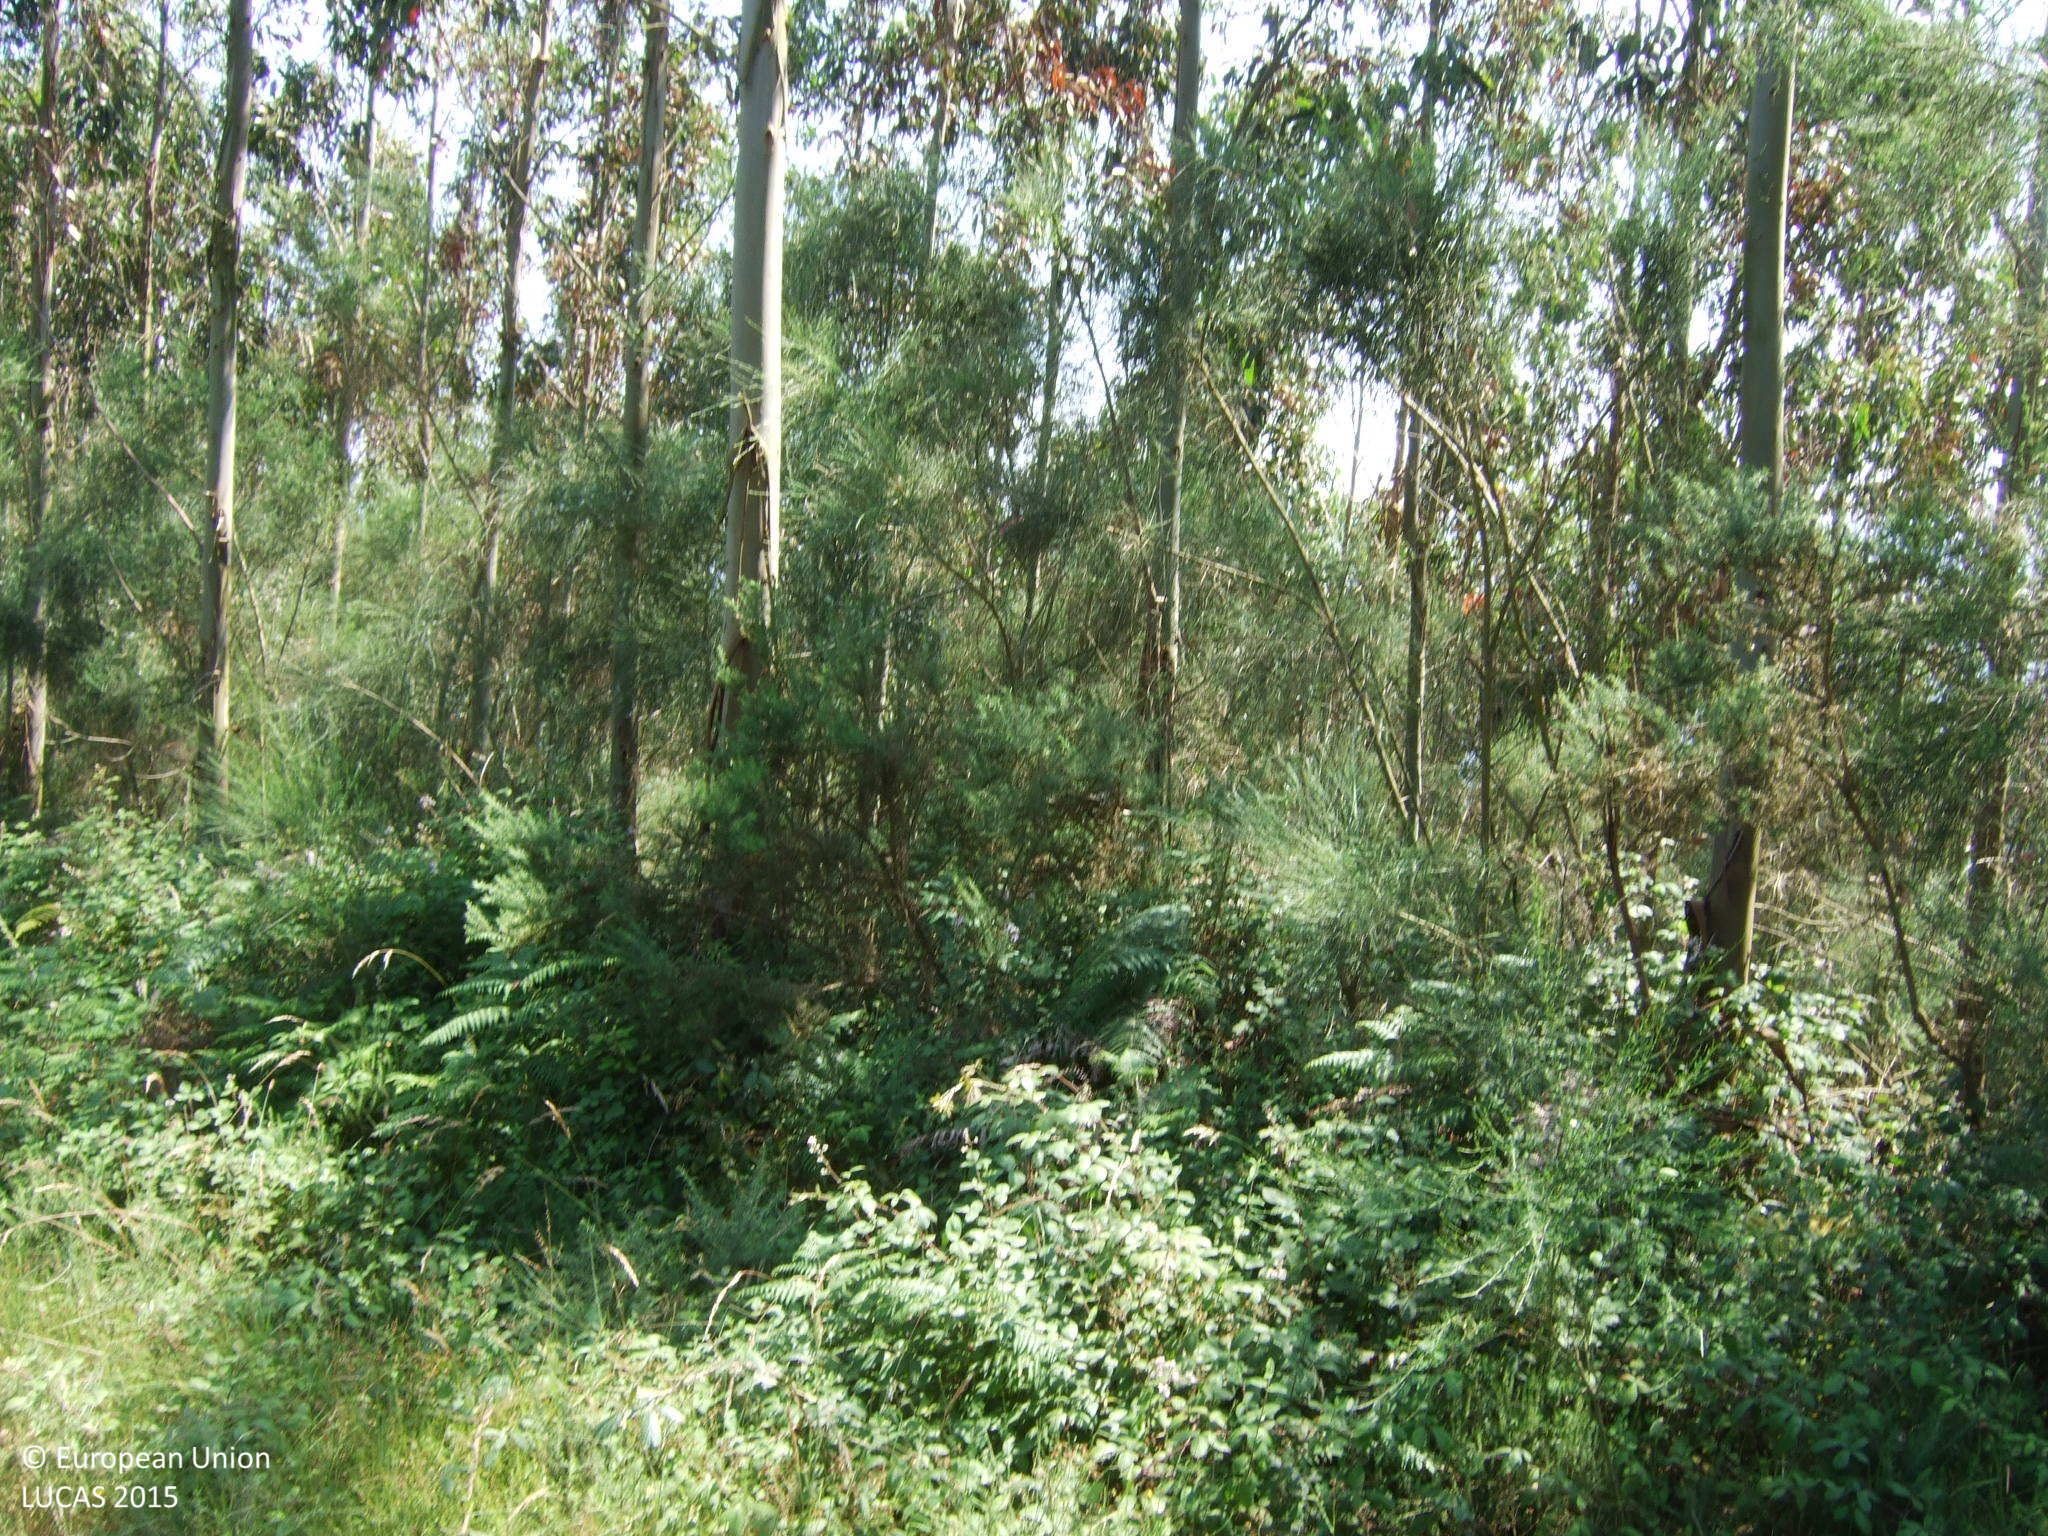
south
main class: Woodland
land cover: Pine dominated mixed woodland
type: exotic forest
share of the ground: 25 - 50 %
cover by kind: shrubs 50 %, coniferous forest trees 25 %, broadleaved forest trees 25 %
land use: Forestry
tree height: < 5 m
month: June
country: ES
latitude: 43.4554
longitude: -7.1888
